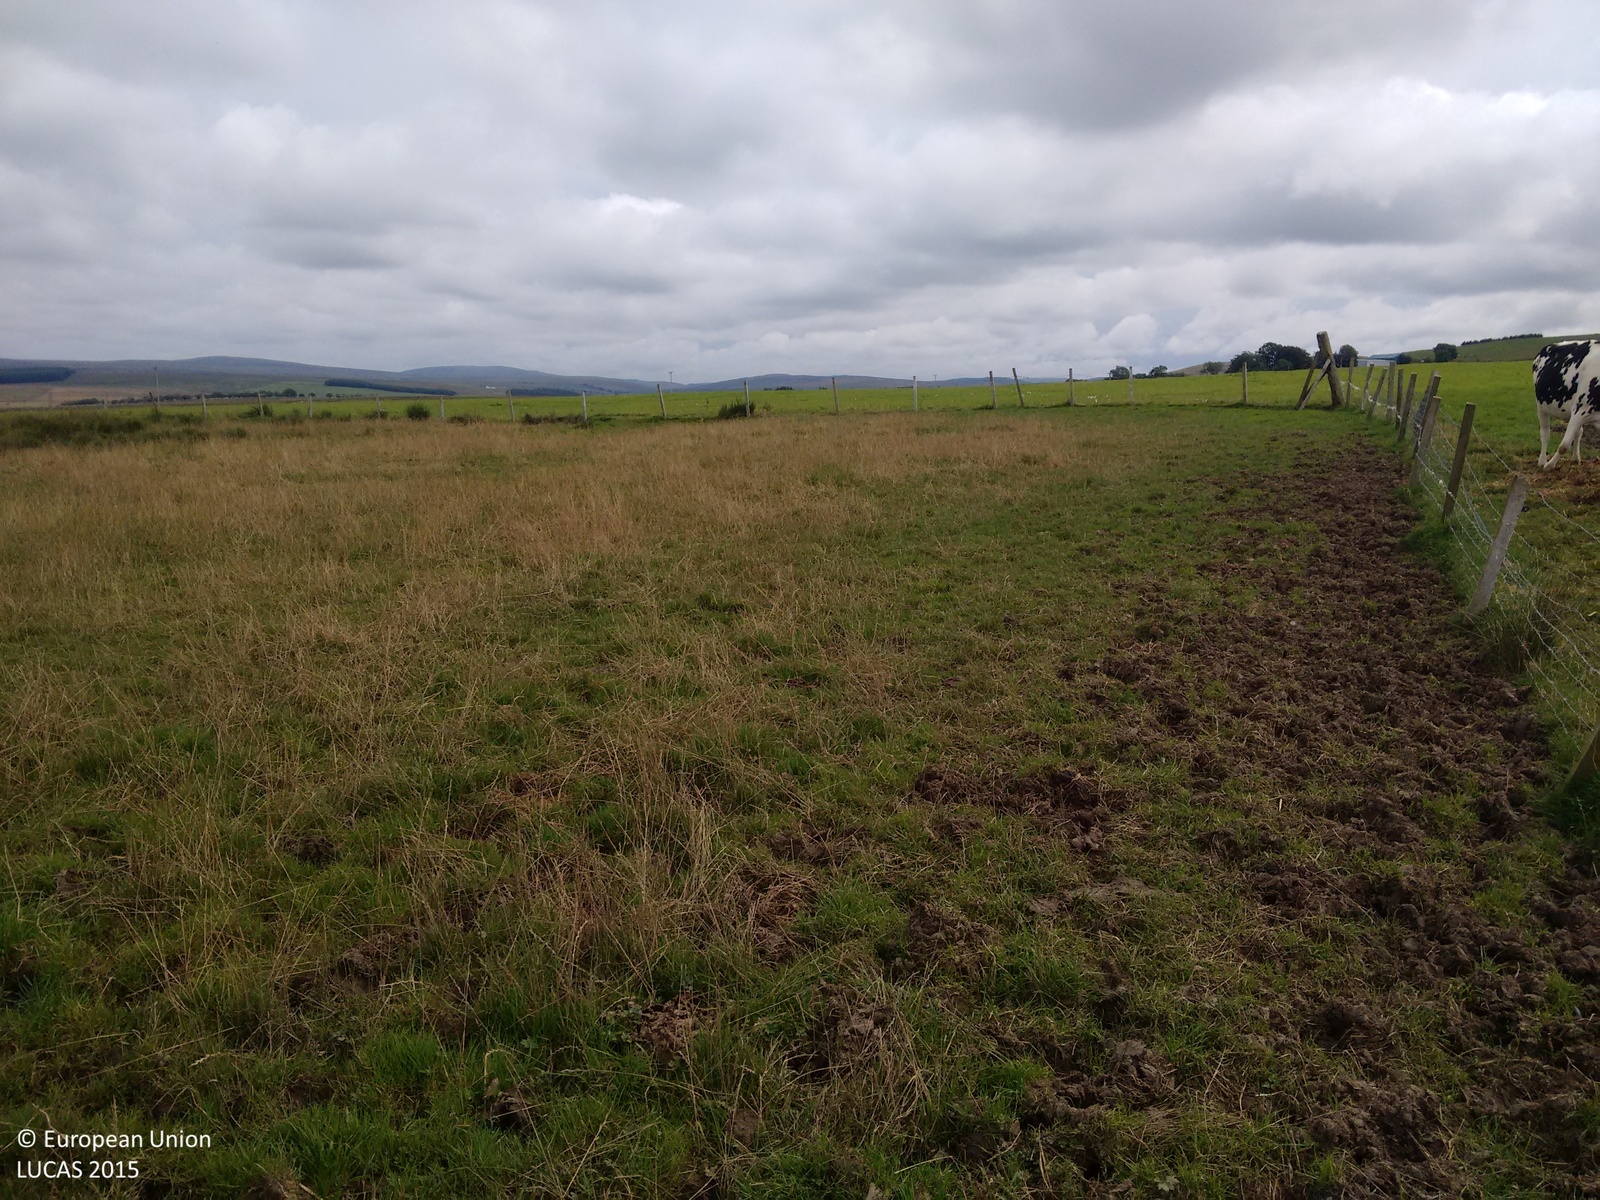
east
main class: Grassland
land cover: Grassland without tree/shrub cover
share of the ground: > 75 %
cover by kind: herbaceous plants 100 %
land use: Agriculture (excluding fallow land and kitchen gardens)
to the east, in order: Grassland without tree/shrub cover
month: August
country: GB
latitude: 55.4460
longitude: -4.2113
